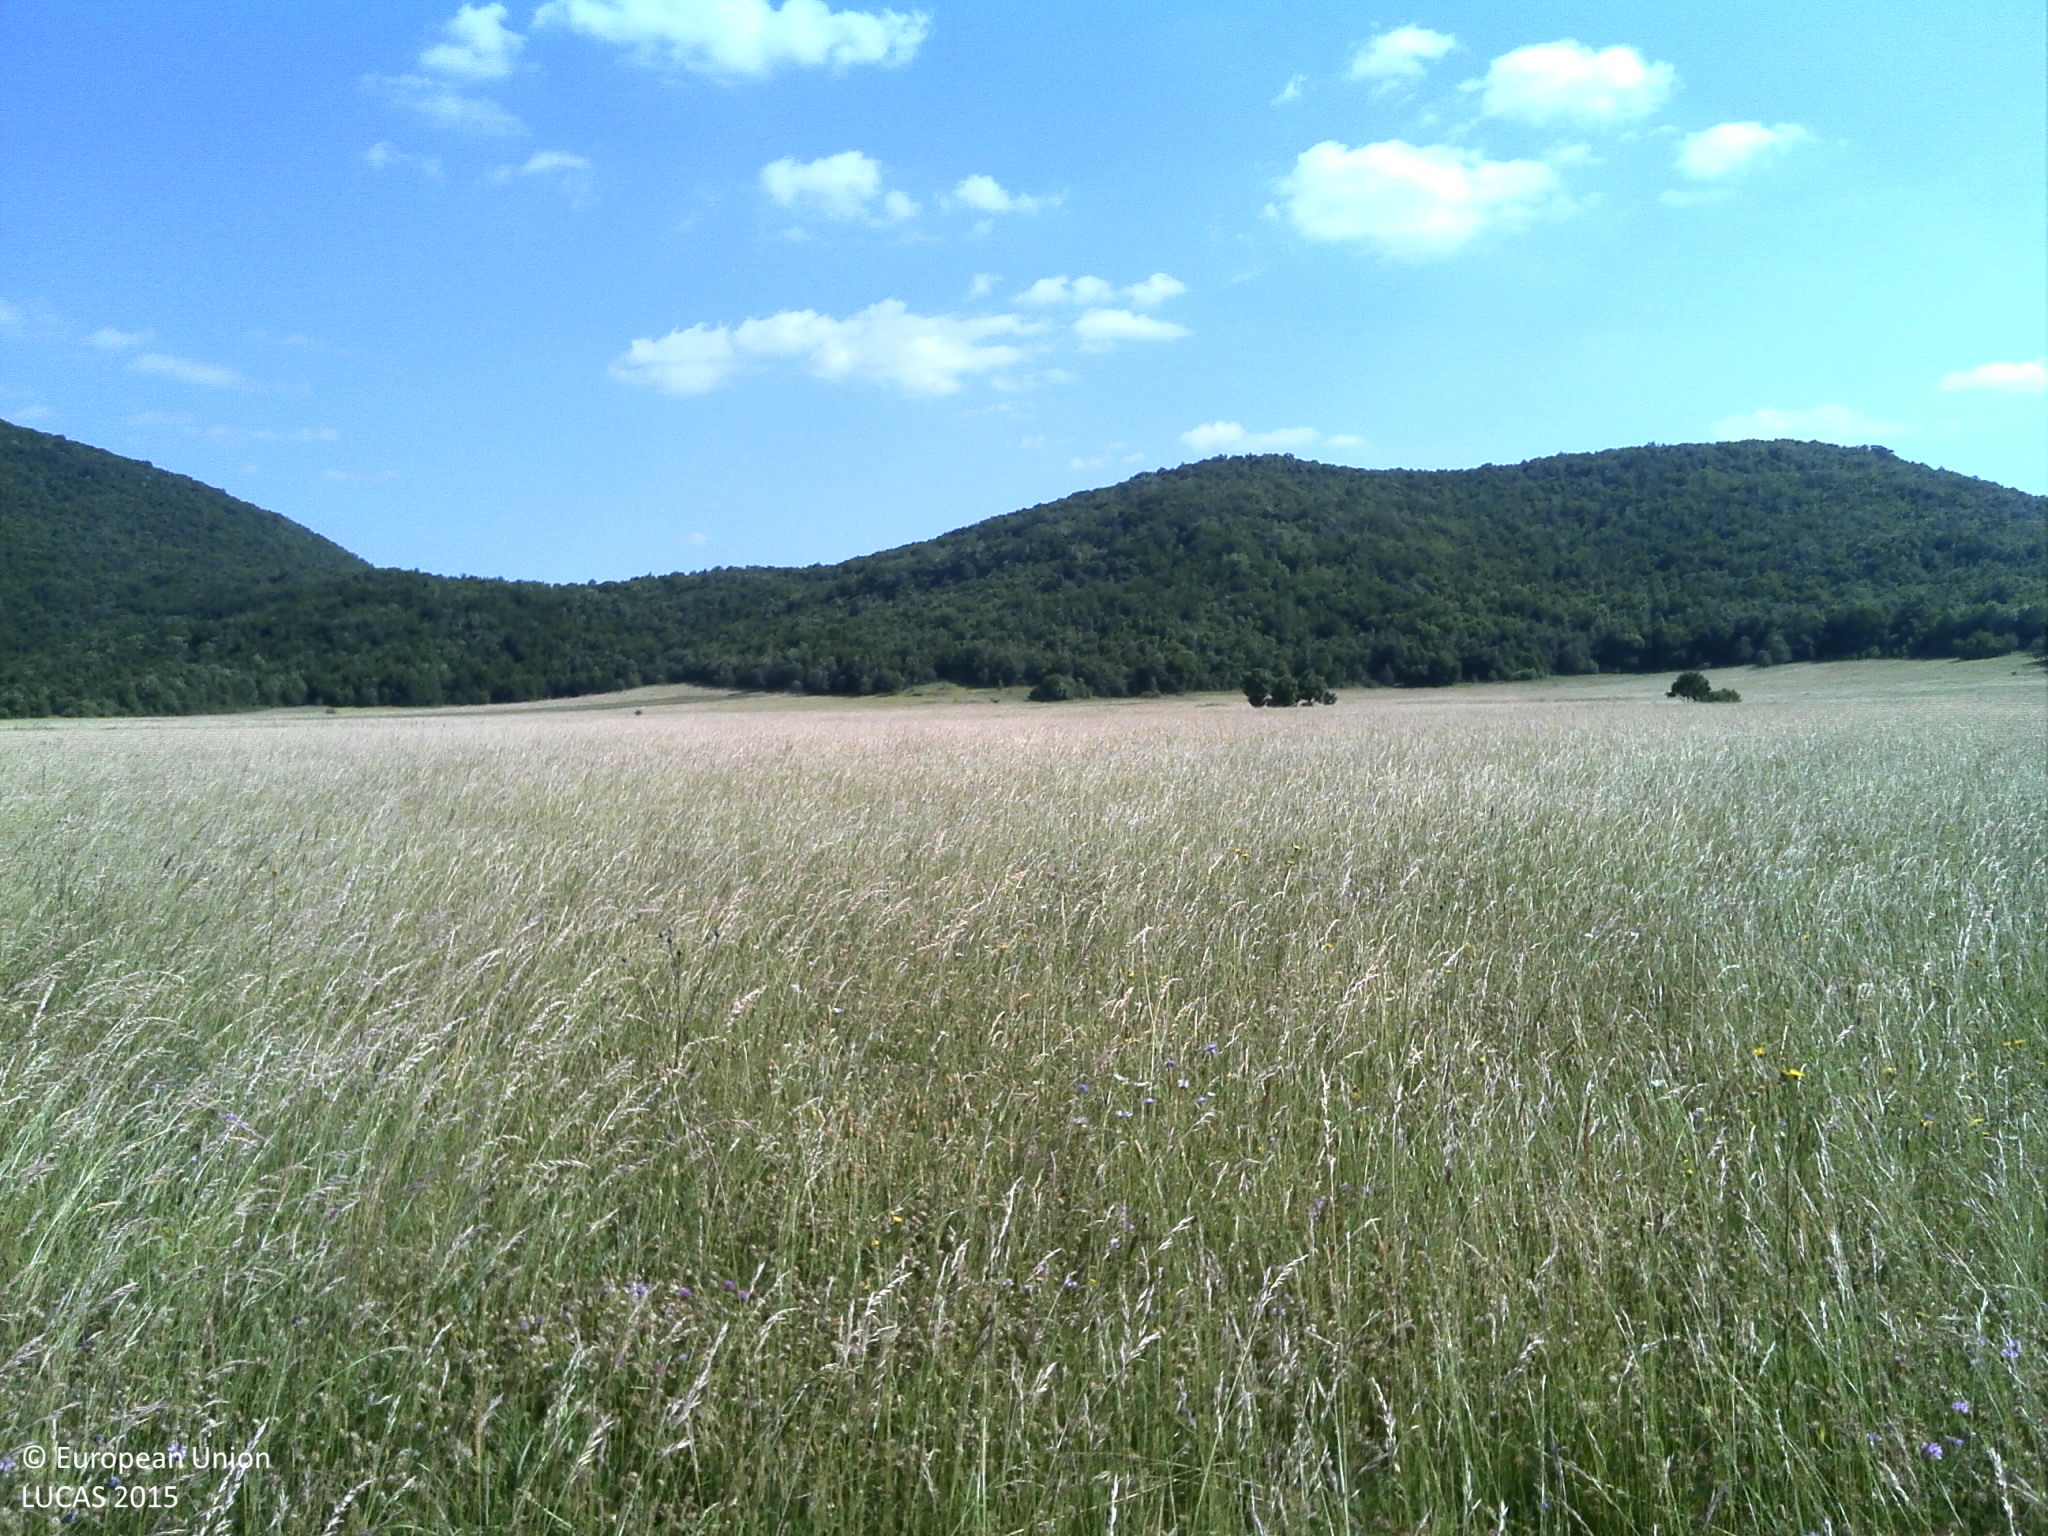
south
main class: Grassland
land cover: Grassland without tree/shrub cover
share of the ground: > 75 %
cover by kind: herbaceous plants 100 %
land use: Abandoned areas
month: June
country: HR
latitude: 44.4298
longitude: 15.6838
